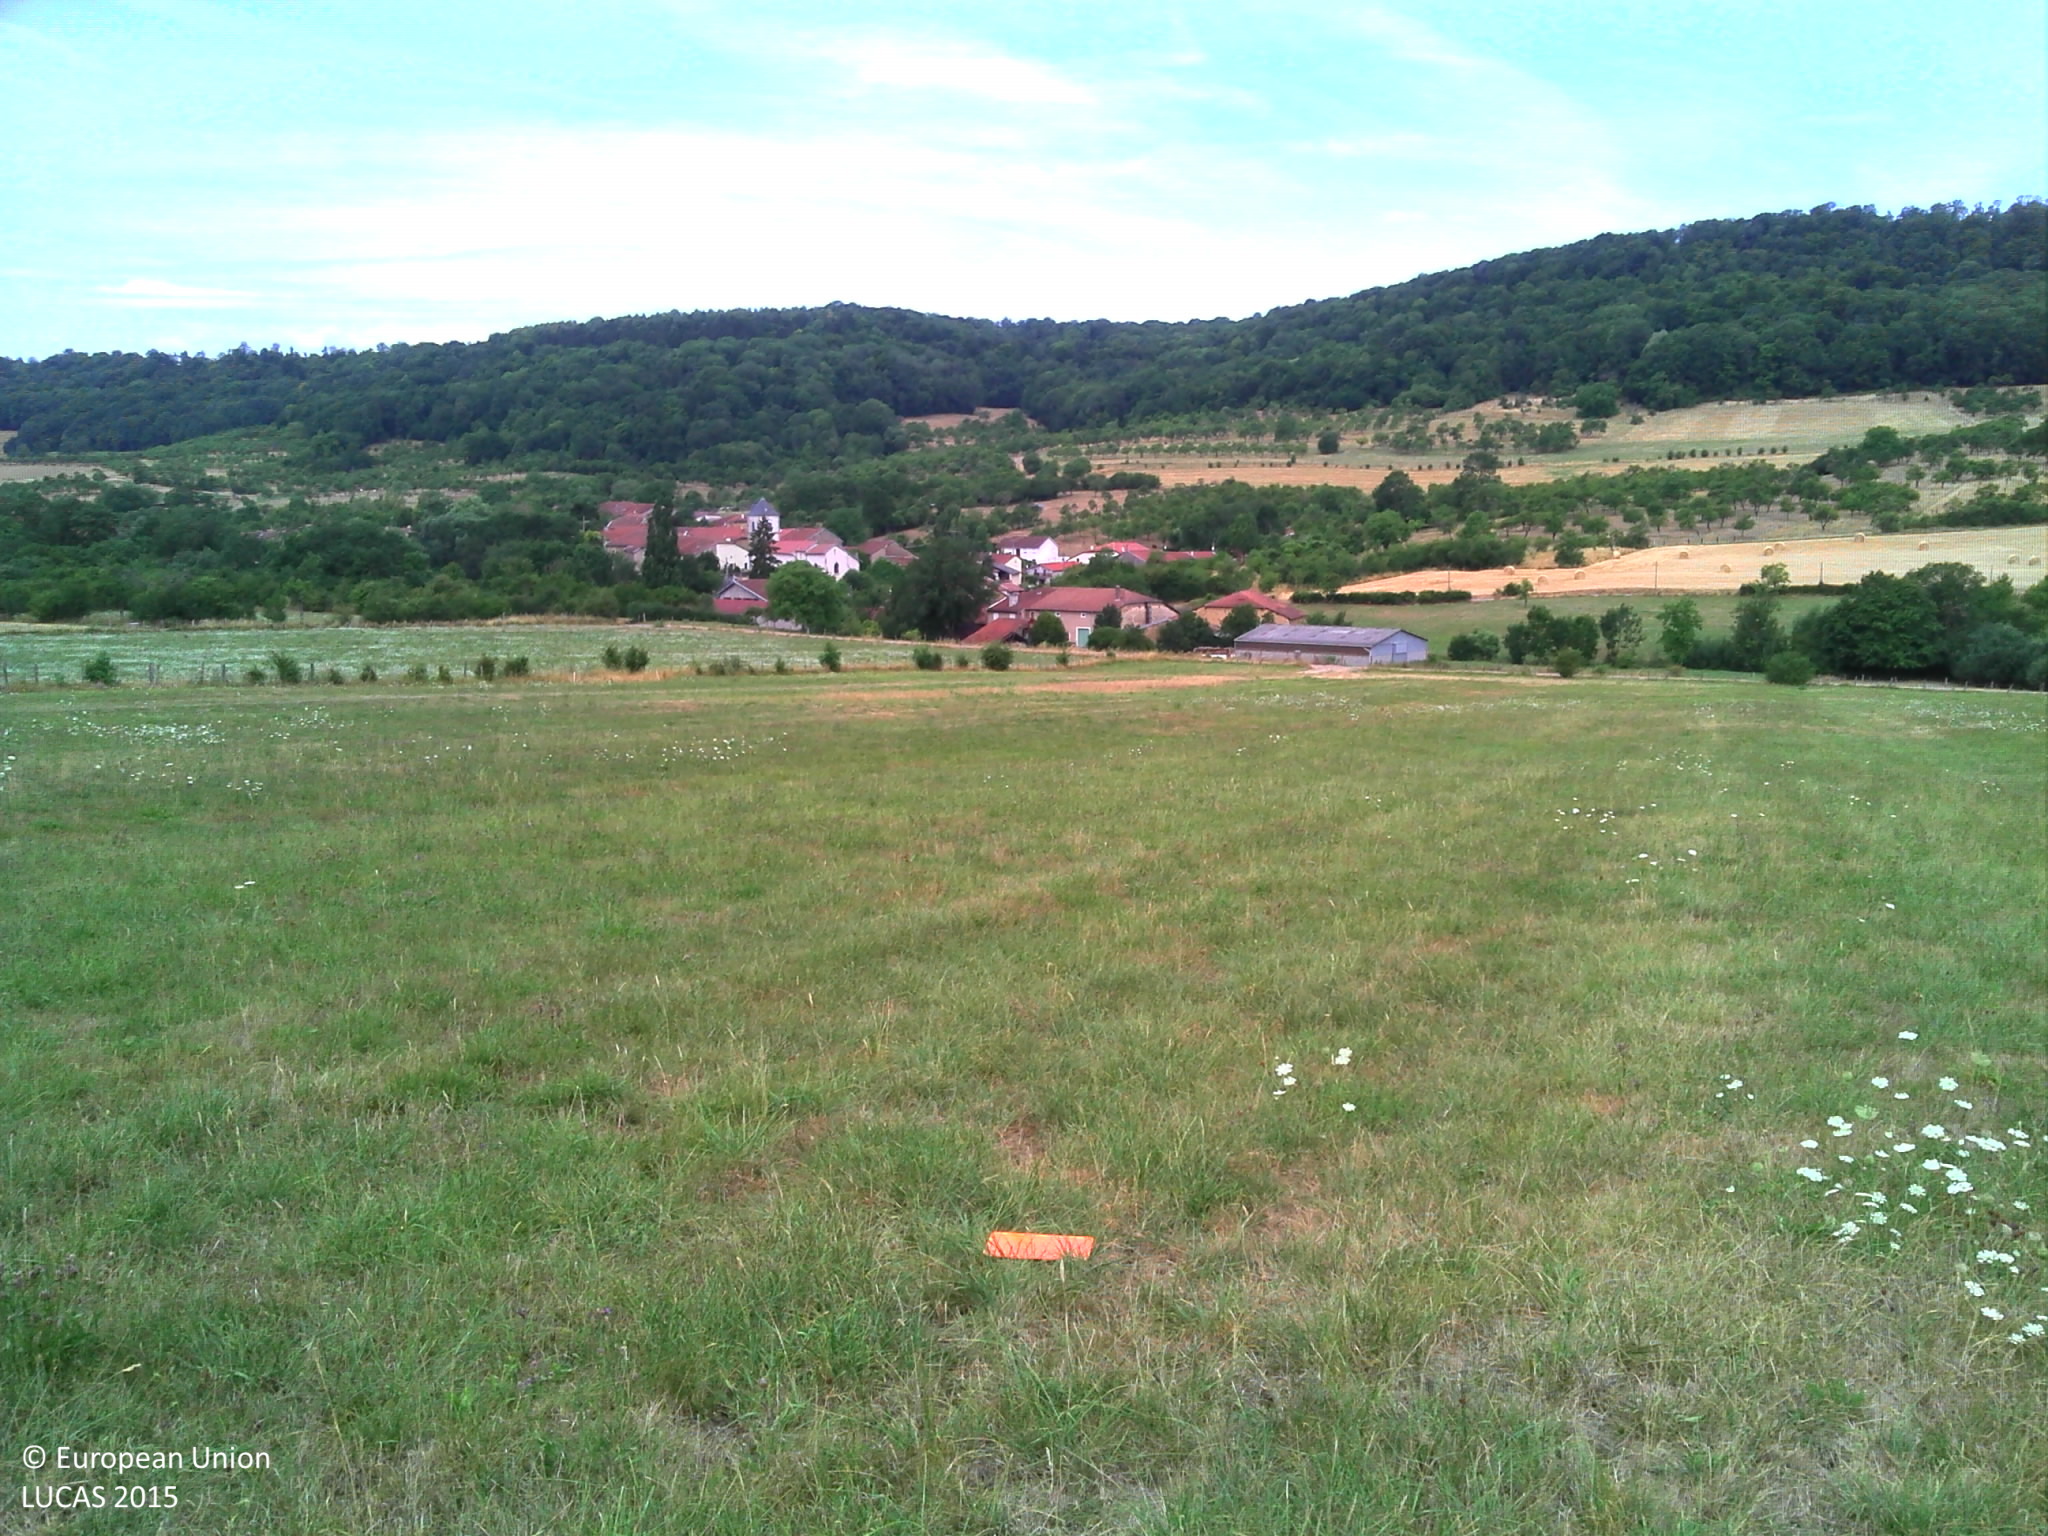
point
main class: Grassland
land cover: Grassland without tree/shrub cover
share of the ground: > 75 %
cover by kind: herbaceous plants 100 %
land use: Agriculture (excluding fallow land and kitchen gardens)
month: July
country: FR
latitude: 48.4038
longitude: 6.0152
